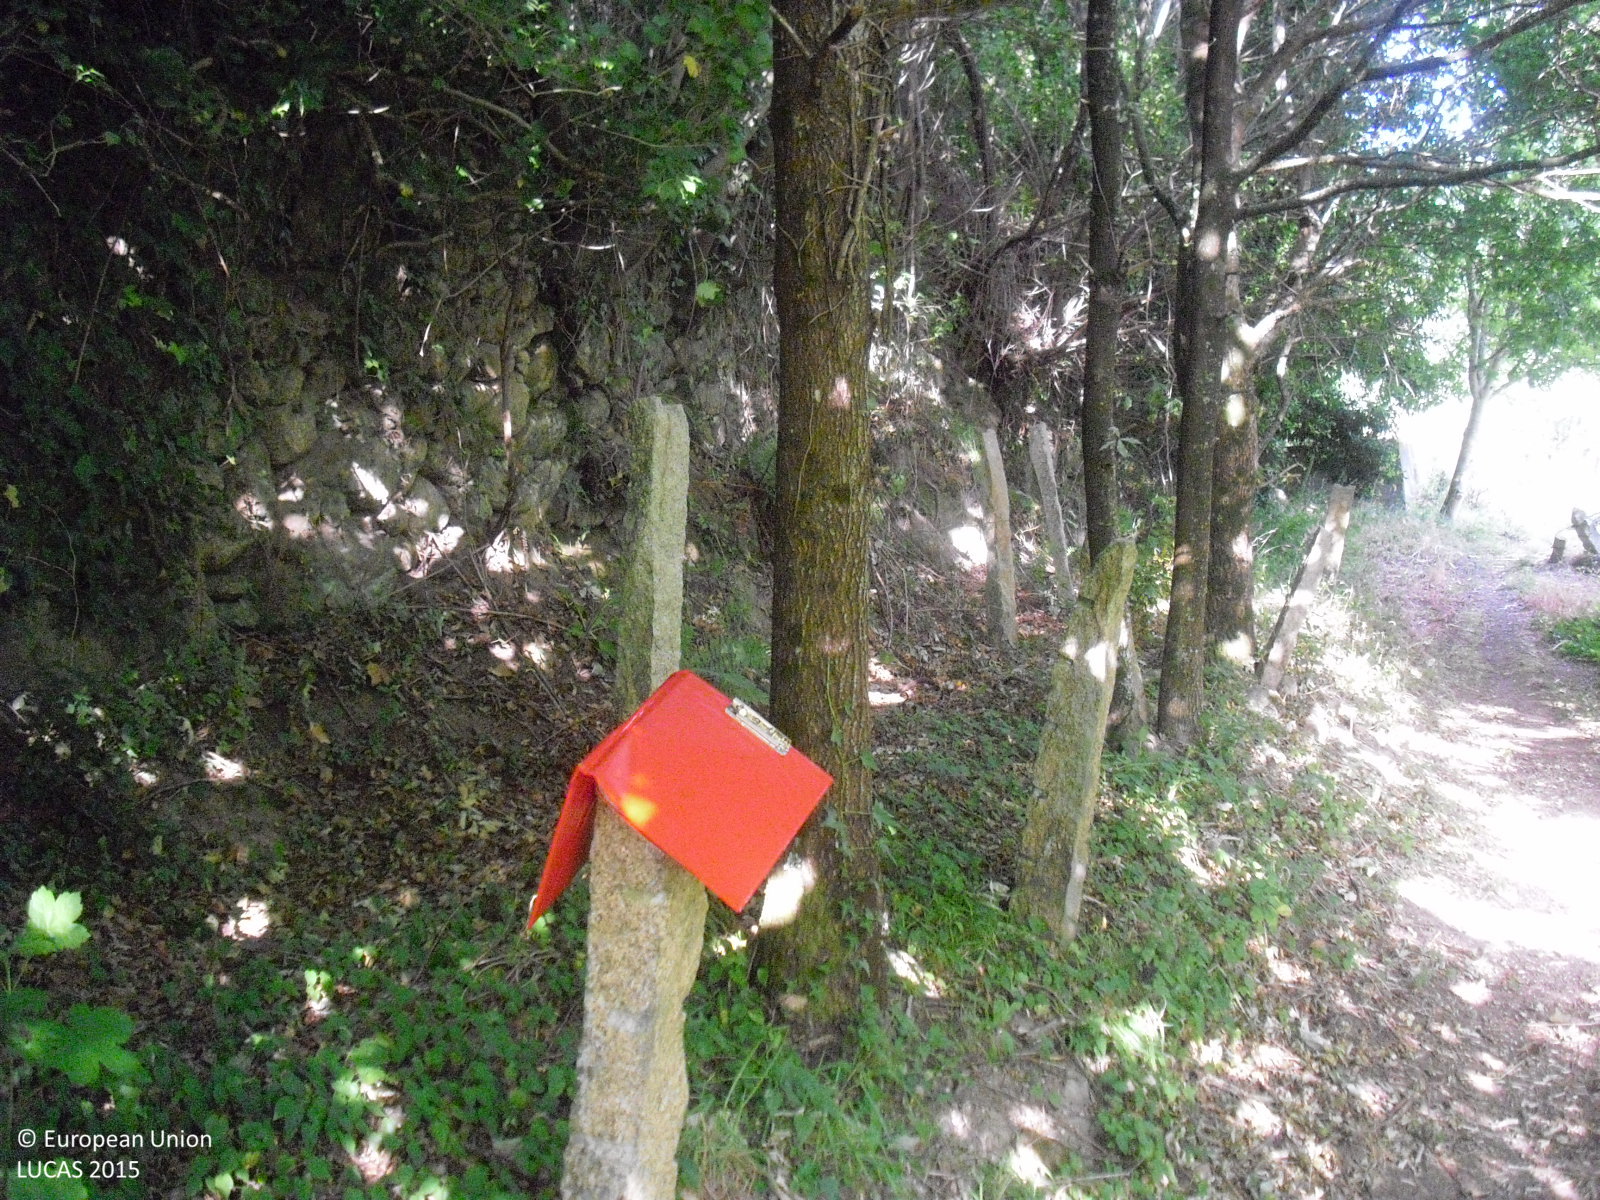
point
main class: Woodland
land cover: Broadleaved woodland
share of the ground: > 75 %
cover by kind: broadleaved forest trees 100 %
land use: Abandoned areas
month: June
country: ES
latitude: 42.1169
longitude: -8.1895
